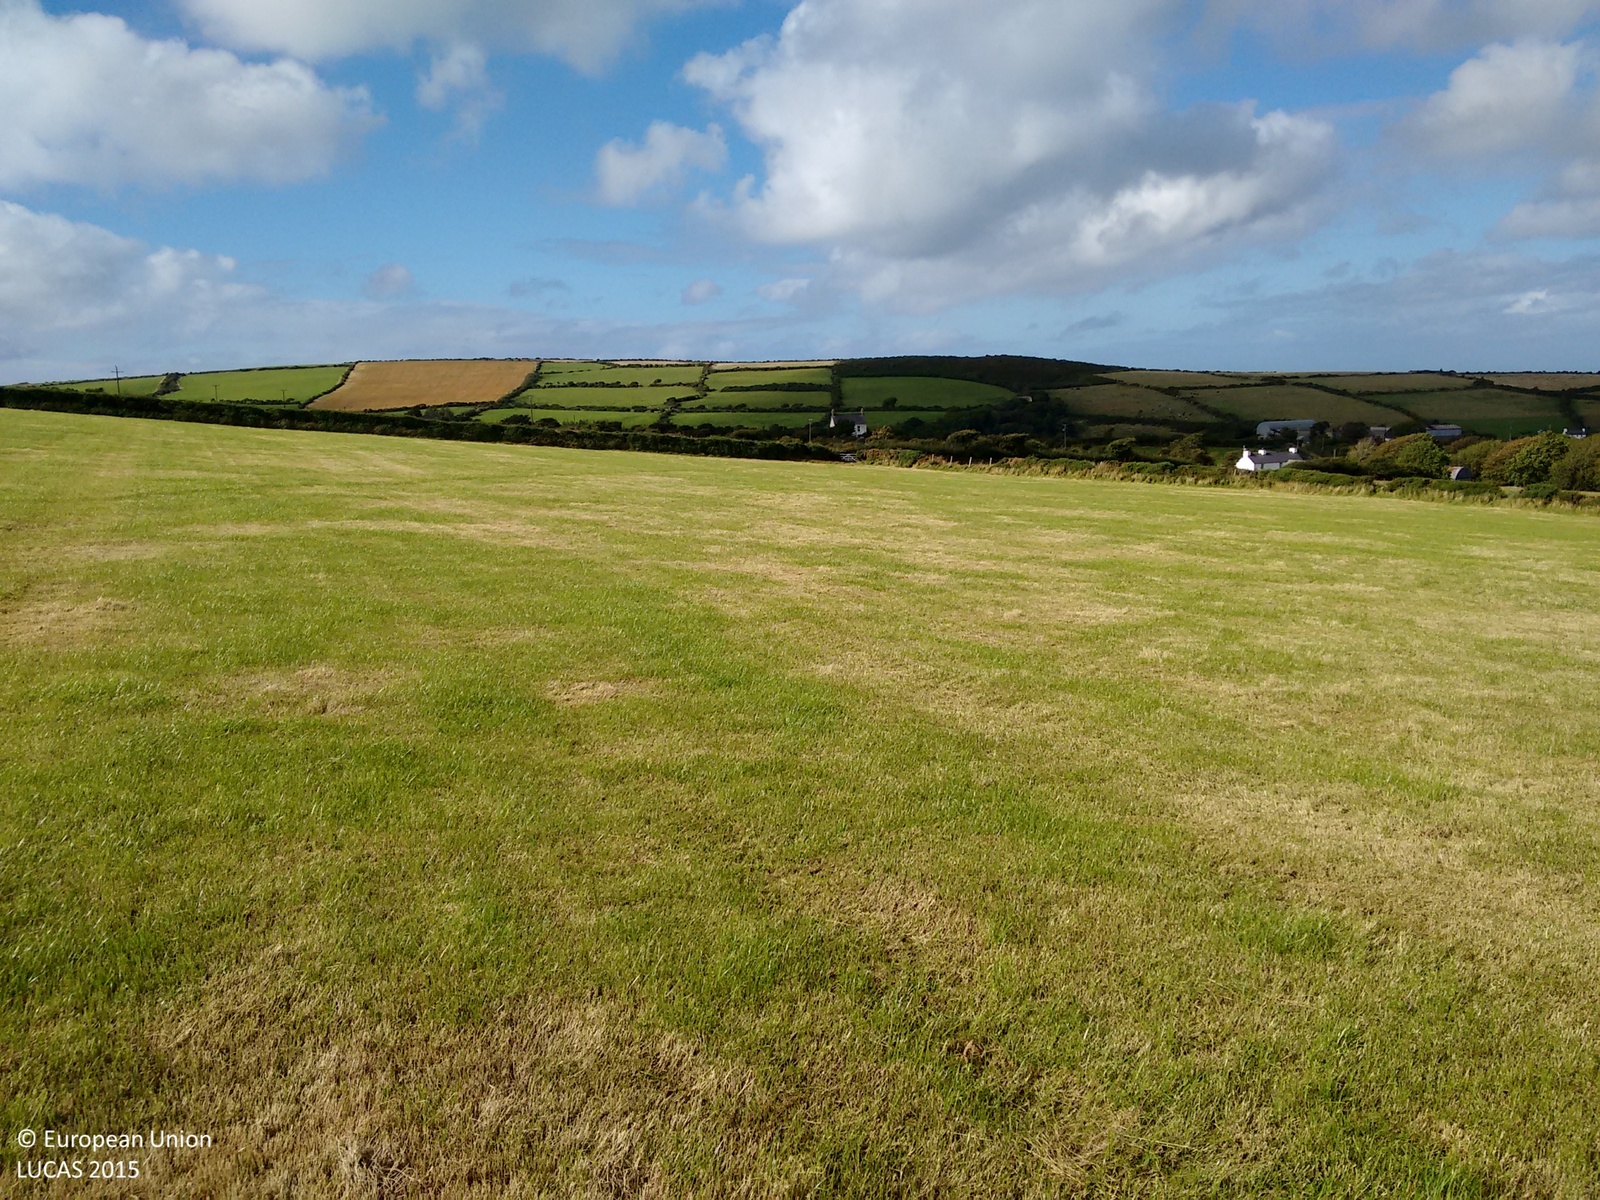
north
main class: Grassland
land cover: Grassland without tree/shrub cover
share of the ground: > 75 %
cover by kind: herbaceous plants 75 %, consolidated bare surface 25 %
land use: Agriculture (excluding fallow land and kitchen gardens)
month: August
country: GB
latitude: 52.0928
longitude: -4.7212
